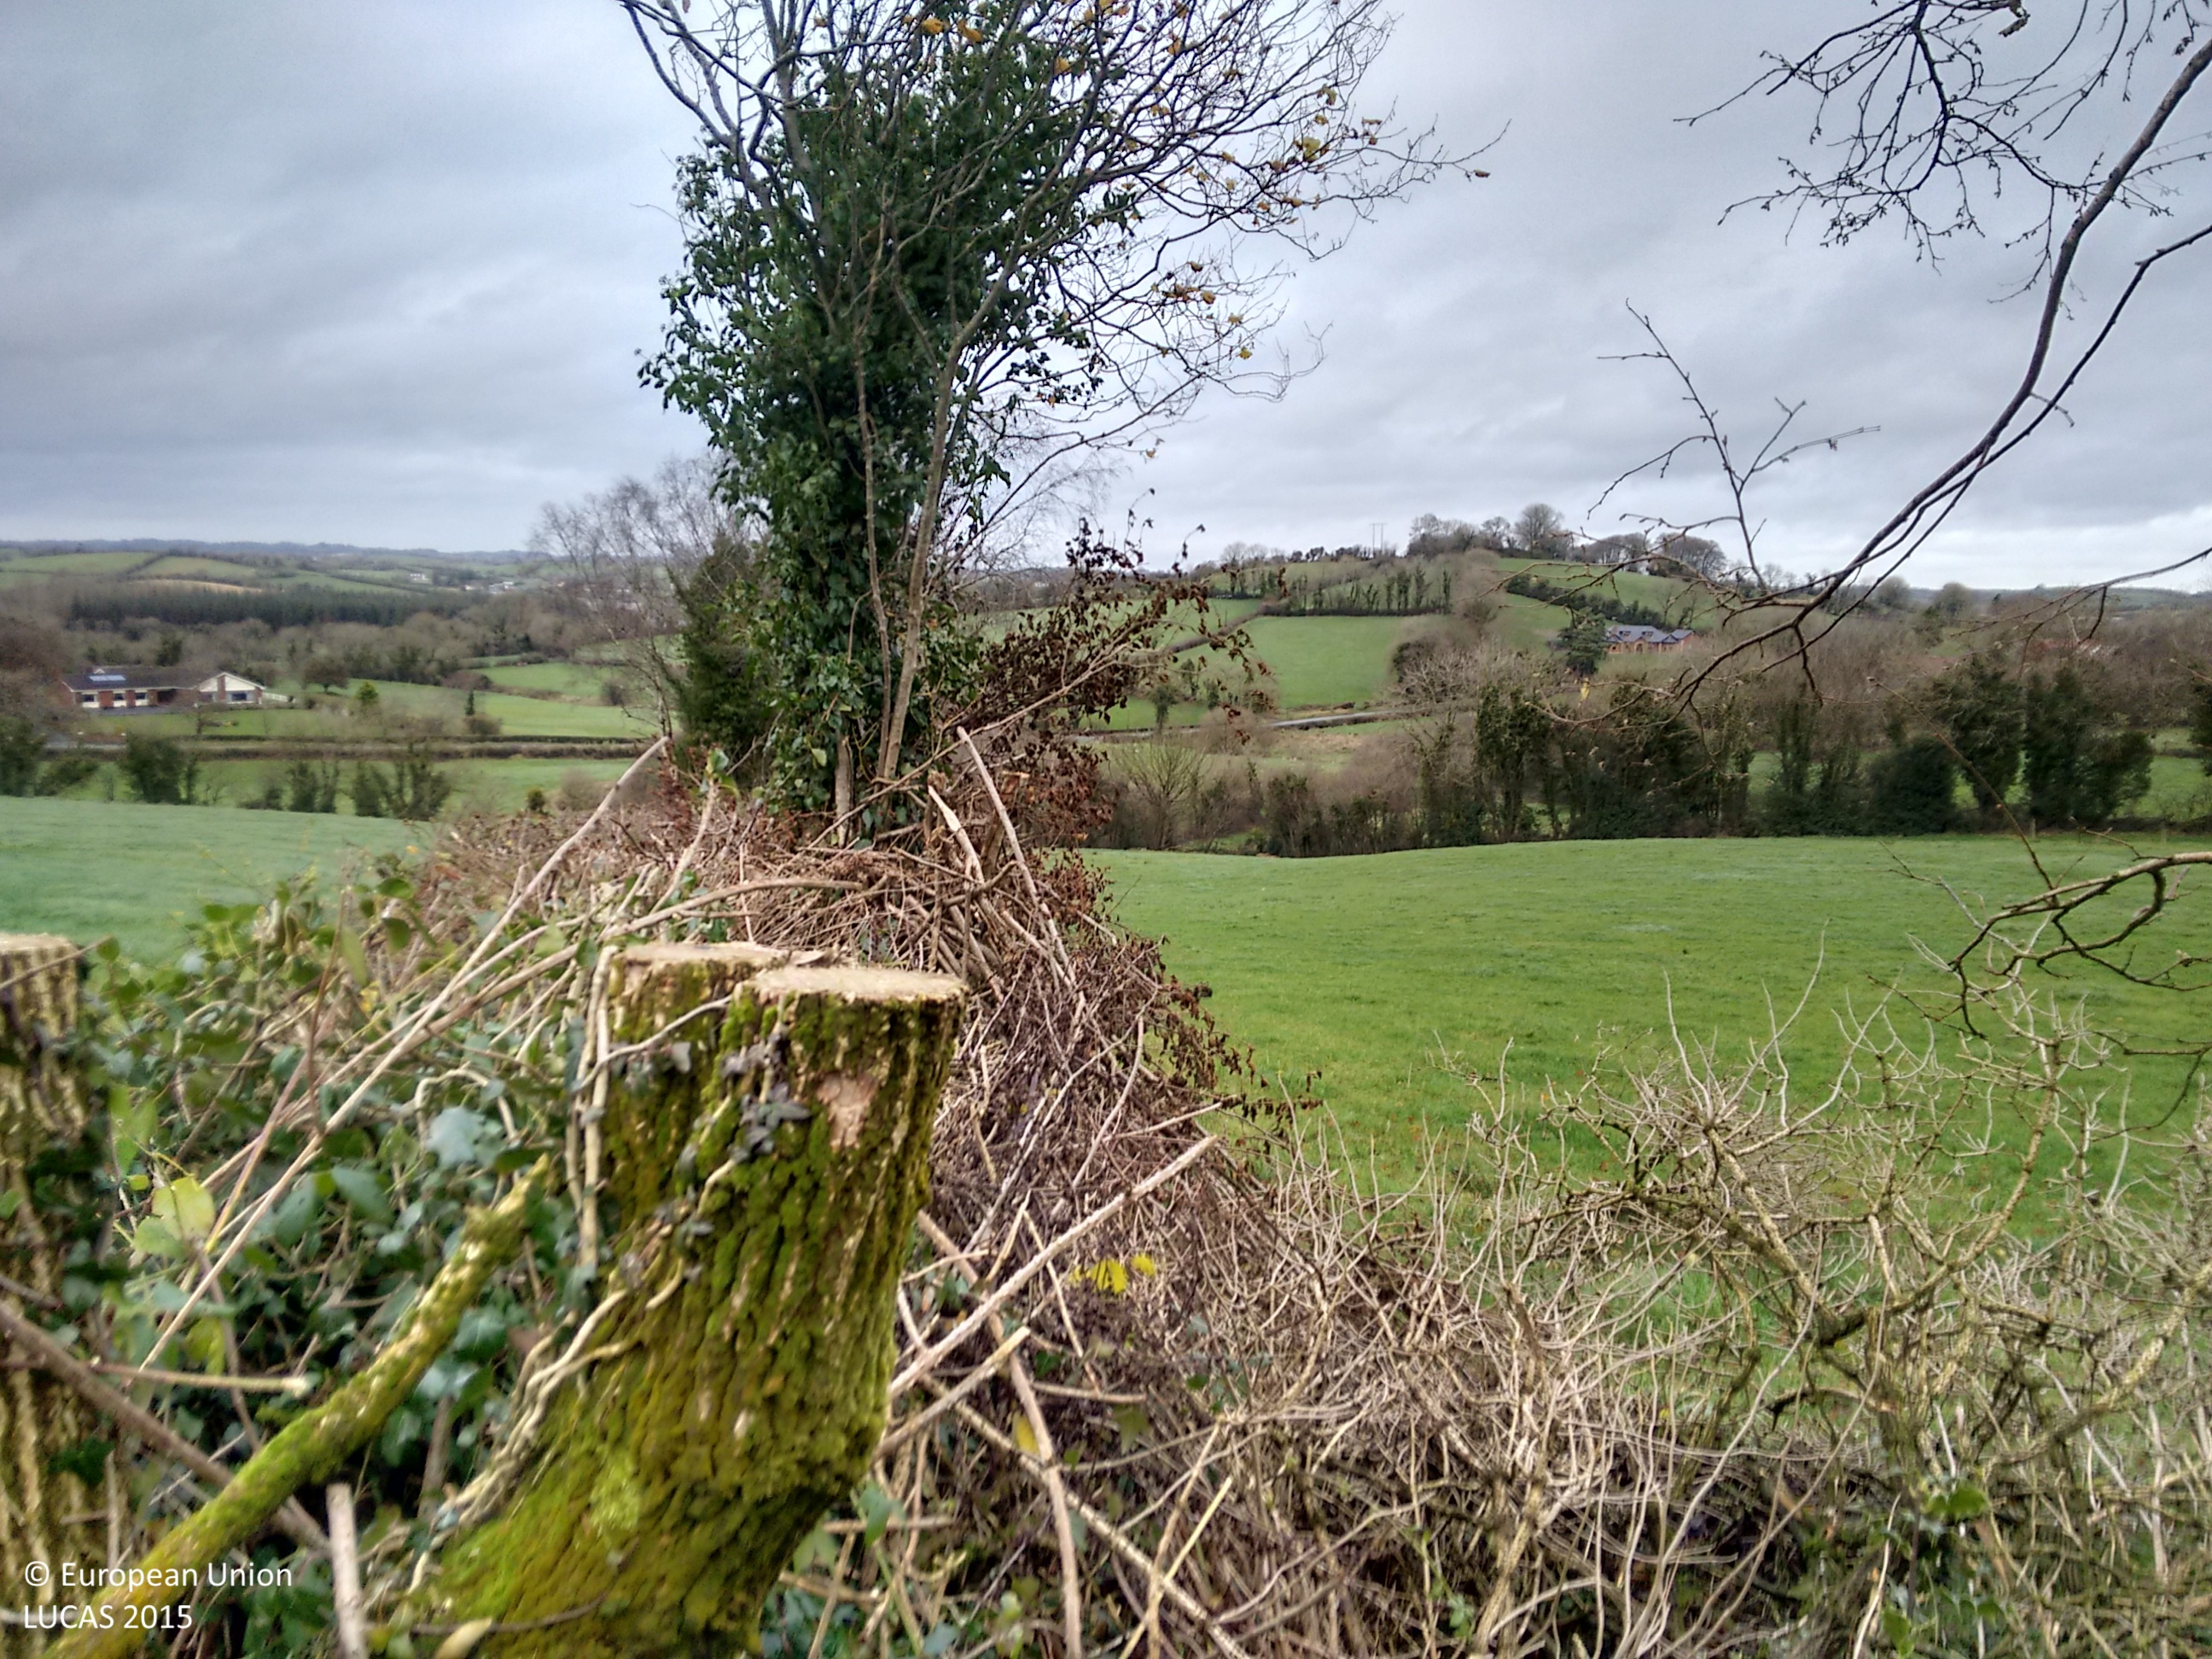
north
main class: Grassland
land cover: Grassland without tree/shrub cover
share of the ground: > 75 %
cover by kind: herbaceous plants 100 %
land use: Agriculture (excluding fallow land and kitchen gardens)
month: December
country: IE
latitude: 54.1124
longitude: -6.9188
